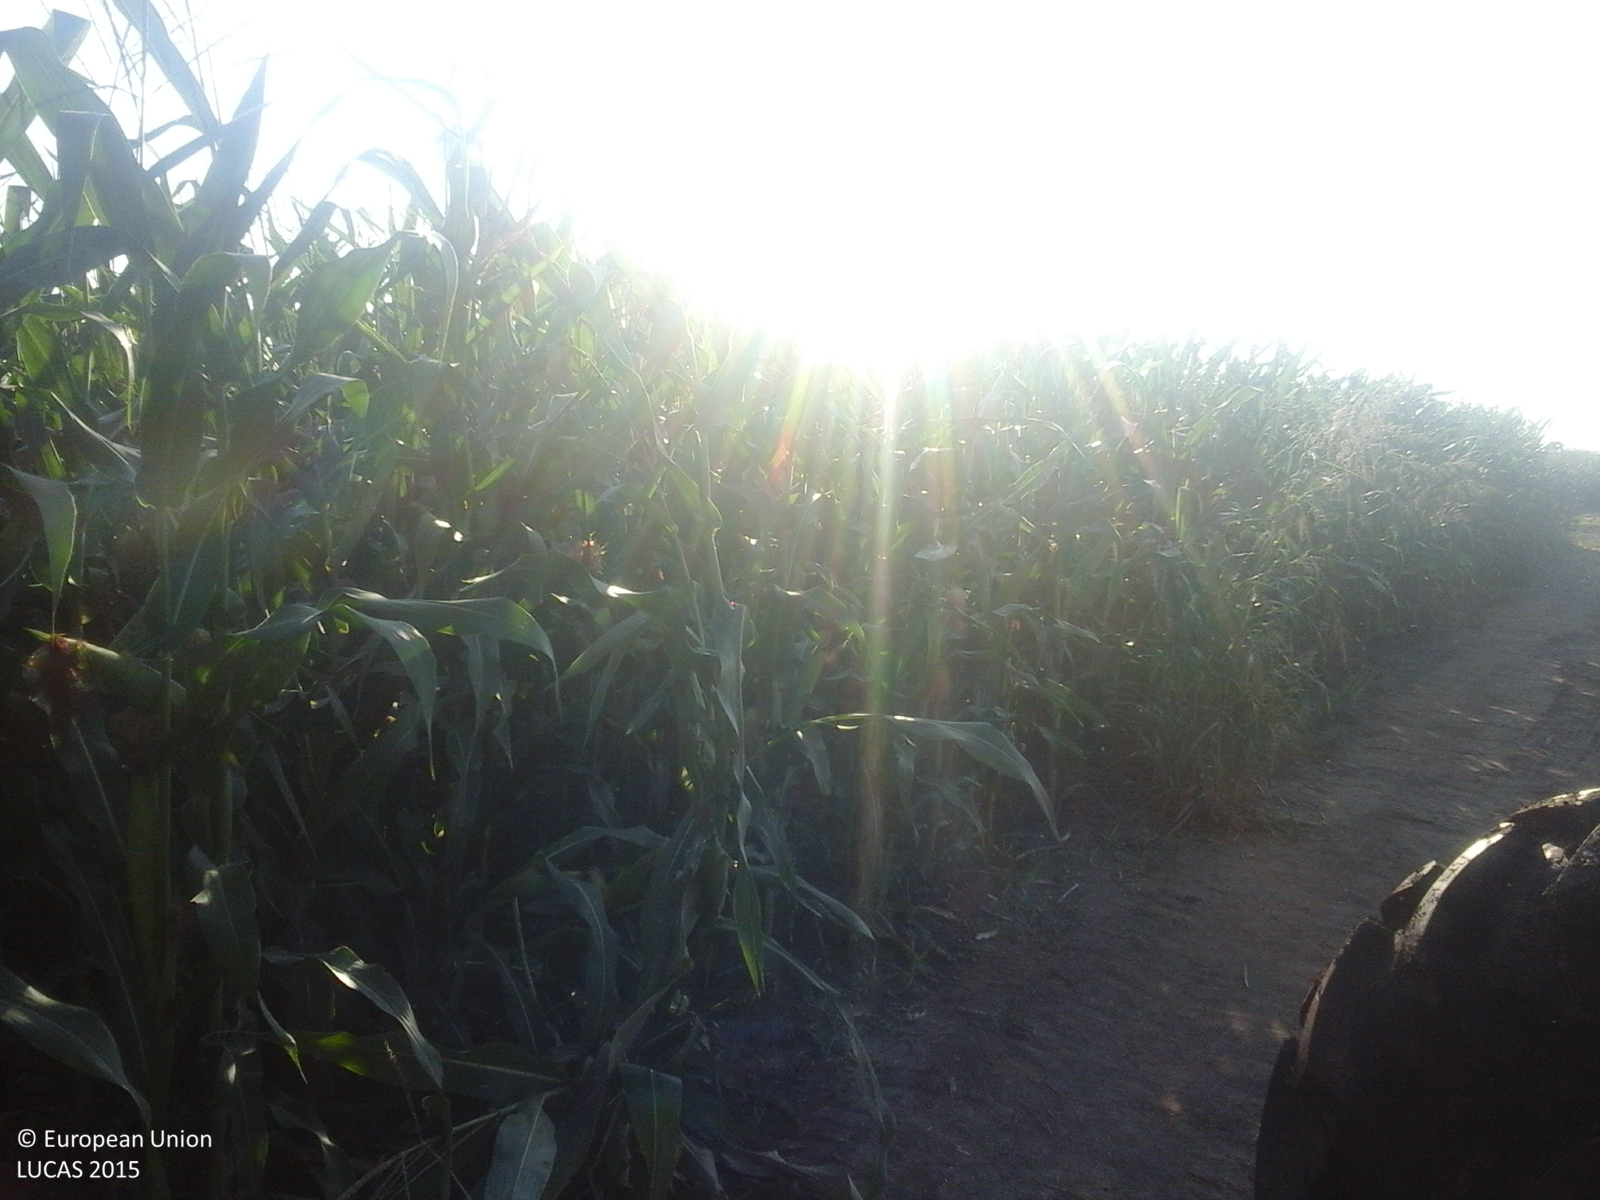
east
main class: Cropland
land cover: Maize
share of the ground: > 75 %
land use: Agriculture (excluding fallow land and kitchen gardens)
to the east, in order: Maize
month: July
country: RO
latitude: 44.4066
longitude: 27.2240
